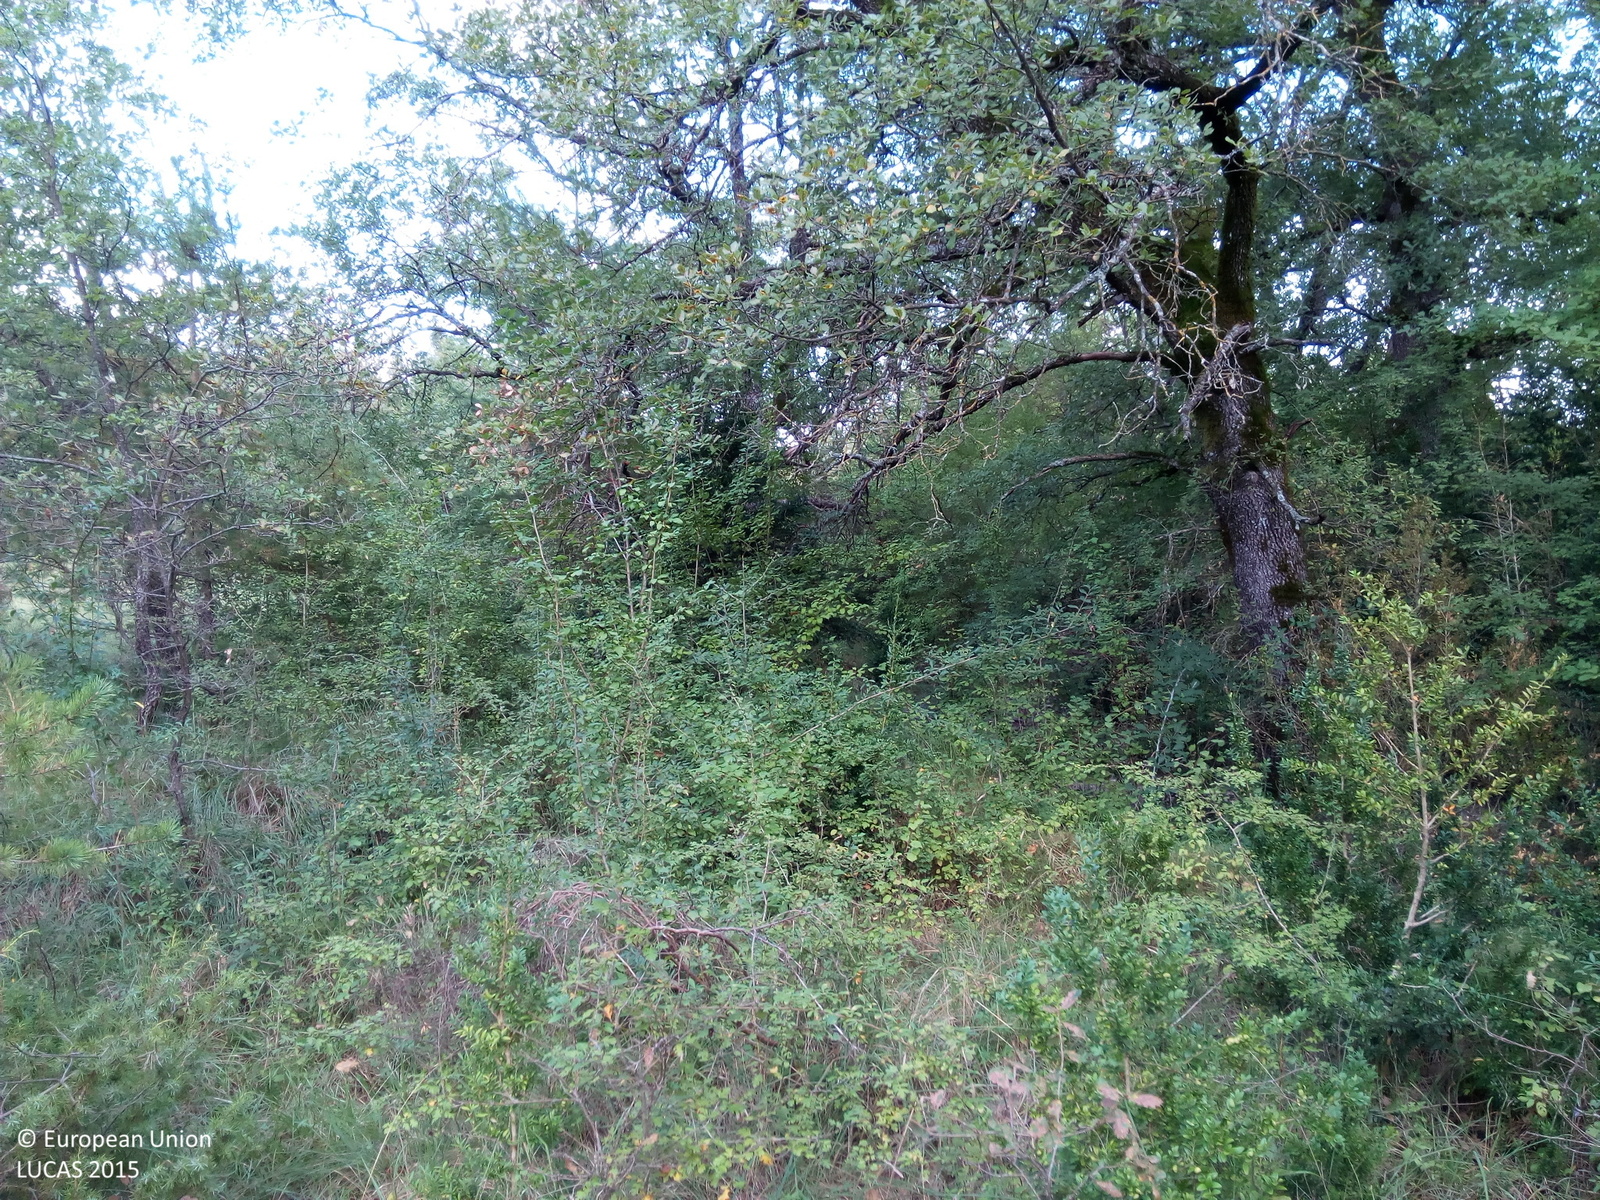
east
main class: Woodland
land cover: Broadleaved woodland
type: broadleaved evergreen forest
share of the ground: > 75 %
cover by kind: broadleaved forest trees 100 %
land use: Semi-natural and natural areas not in use
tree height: > 5 m
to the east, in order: Broadleaved woodland; Shrubland with sparse tree cover; Rivers and streams; Broadleaved woodland; Grassland without tree/shrub cover; Pine dominated mixed woodland; Shrubland with sparse tree cover
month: September
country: ES
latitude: 42.4639
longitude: -0.0316
